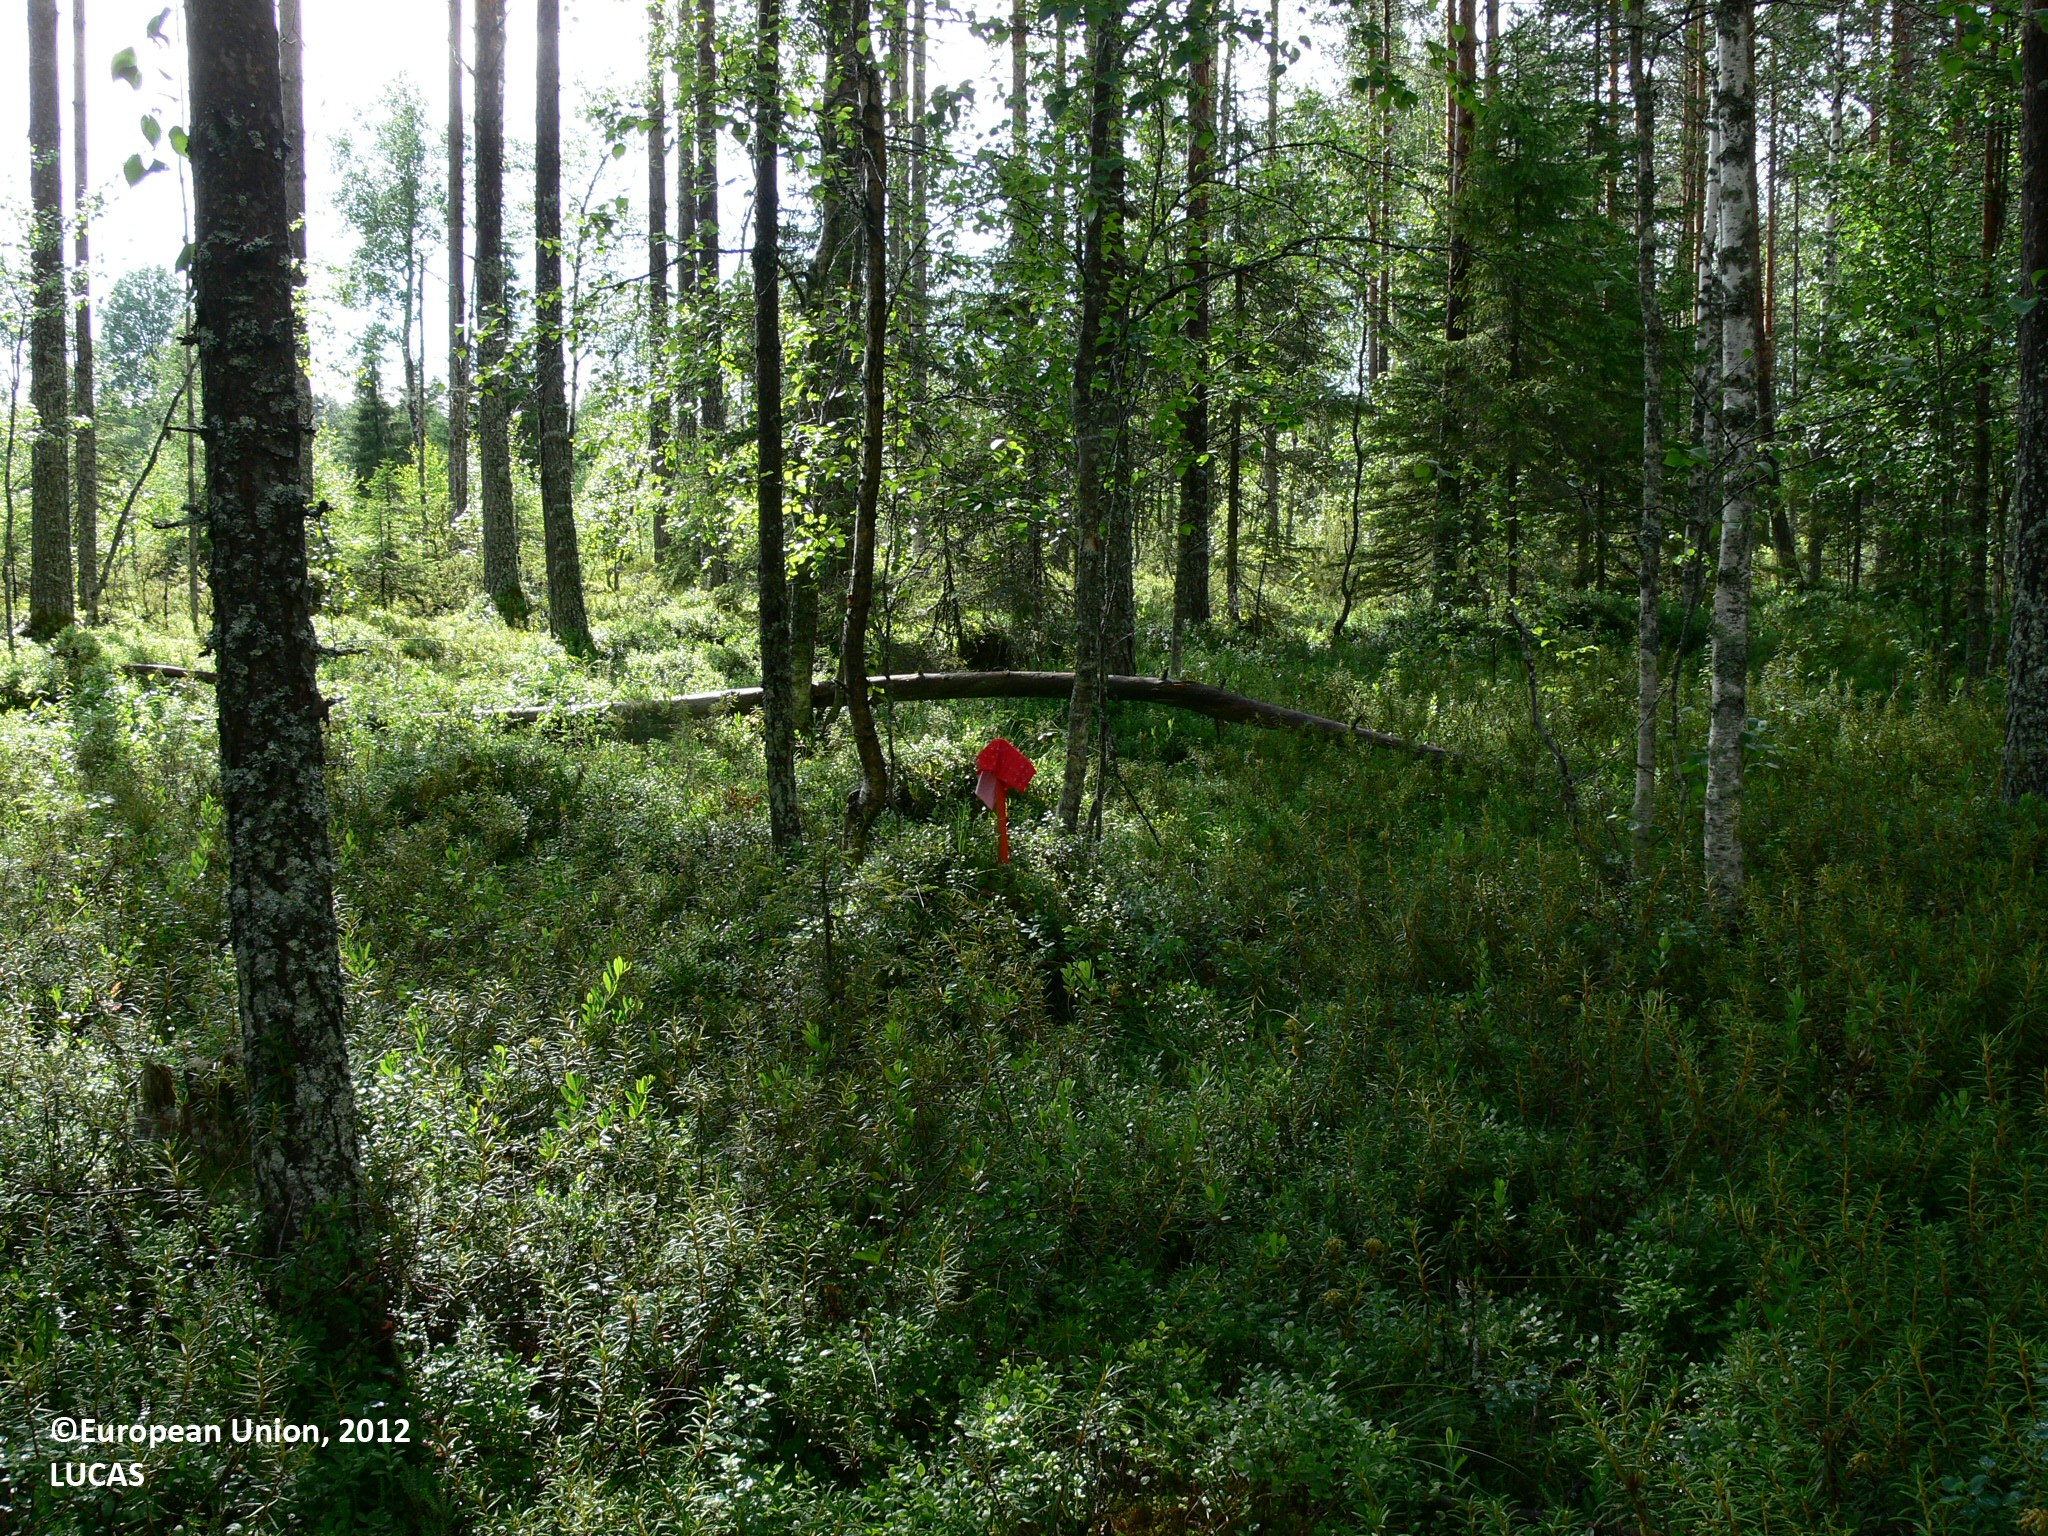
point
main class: Woodland
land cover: Pine dominated mixed woodland
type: boreal forest
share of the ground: 50 - 75 %
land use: Forestry
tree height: > 5 m
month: July
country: FI
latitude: 63.0602
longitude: 29.3174
